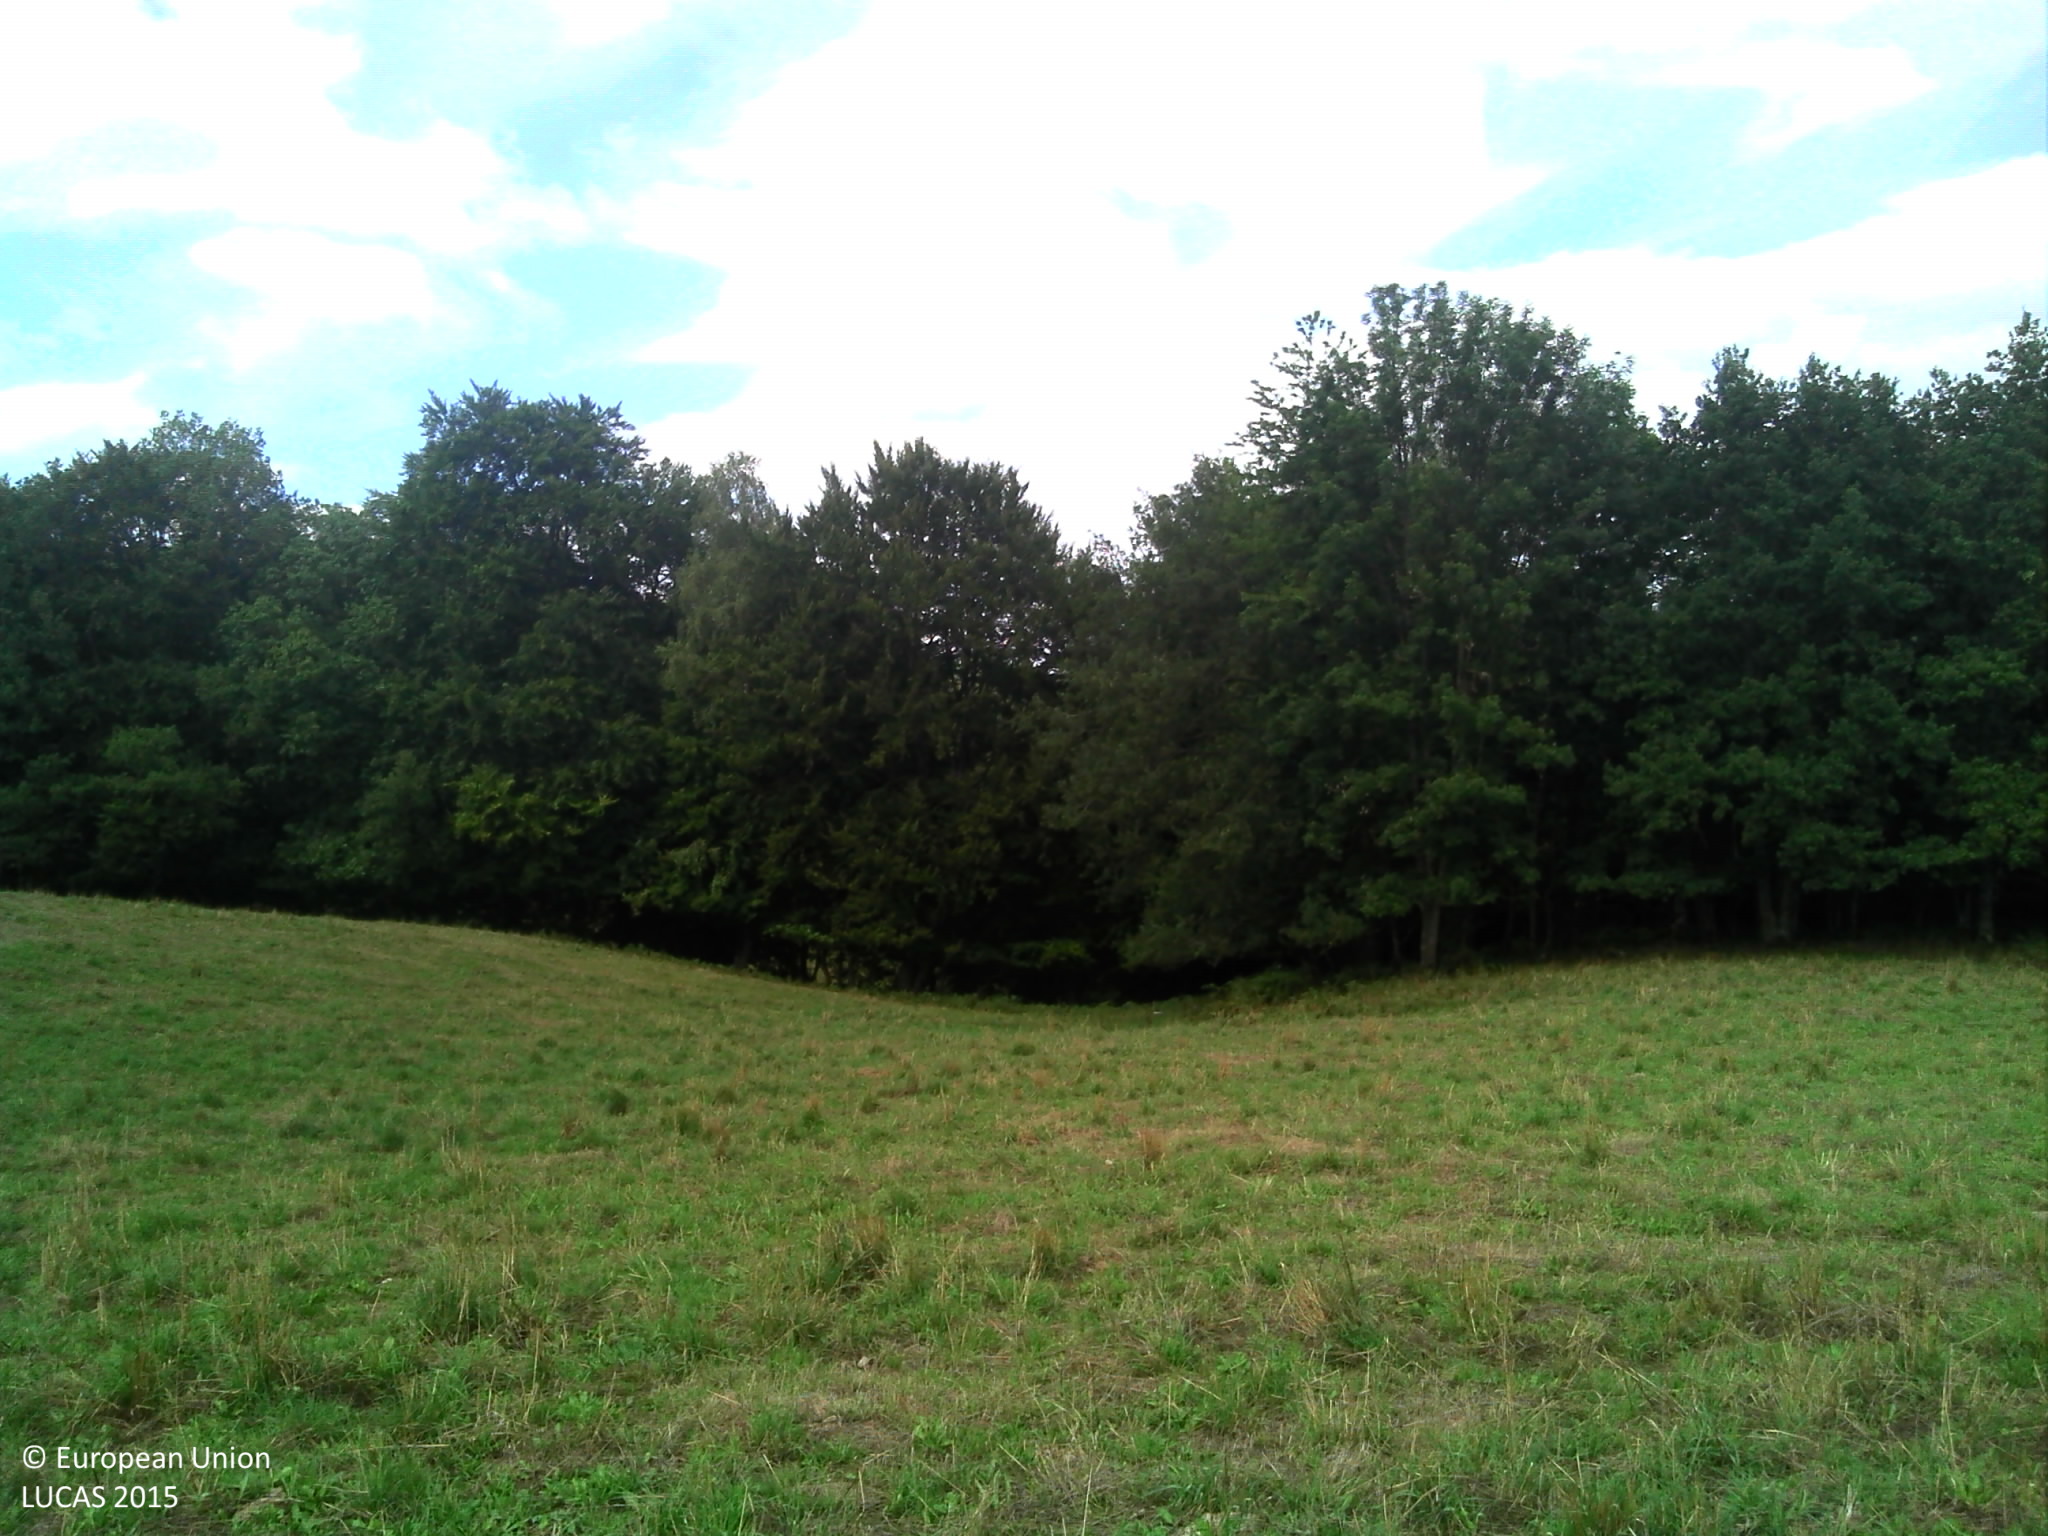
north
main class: Grassland
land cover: Grassland without tree/shrub cover
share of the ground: > 75 %
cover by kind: herbaceous plants 95 %, shrubs 5 %
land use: Agriculture (excluding fallow land and kitchen gardens)
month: August
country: FR
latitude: 45.9963
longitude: 2.2357
